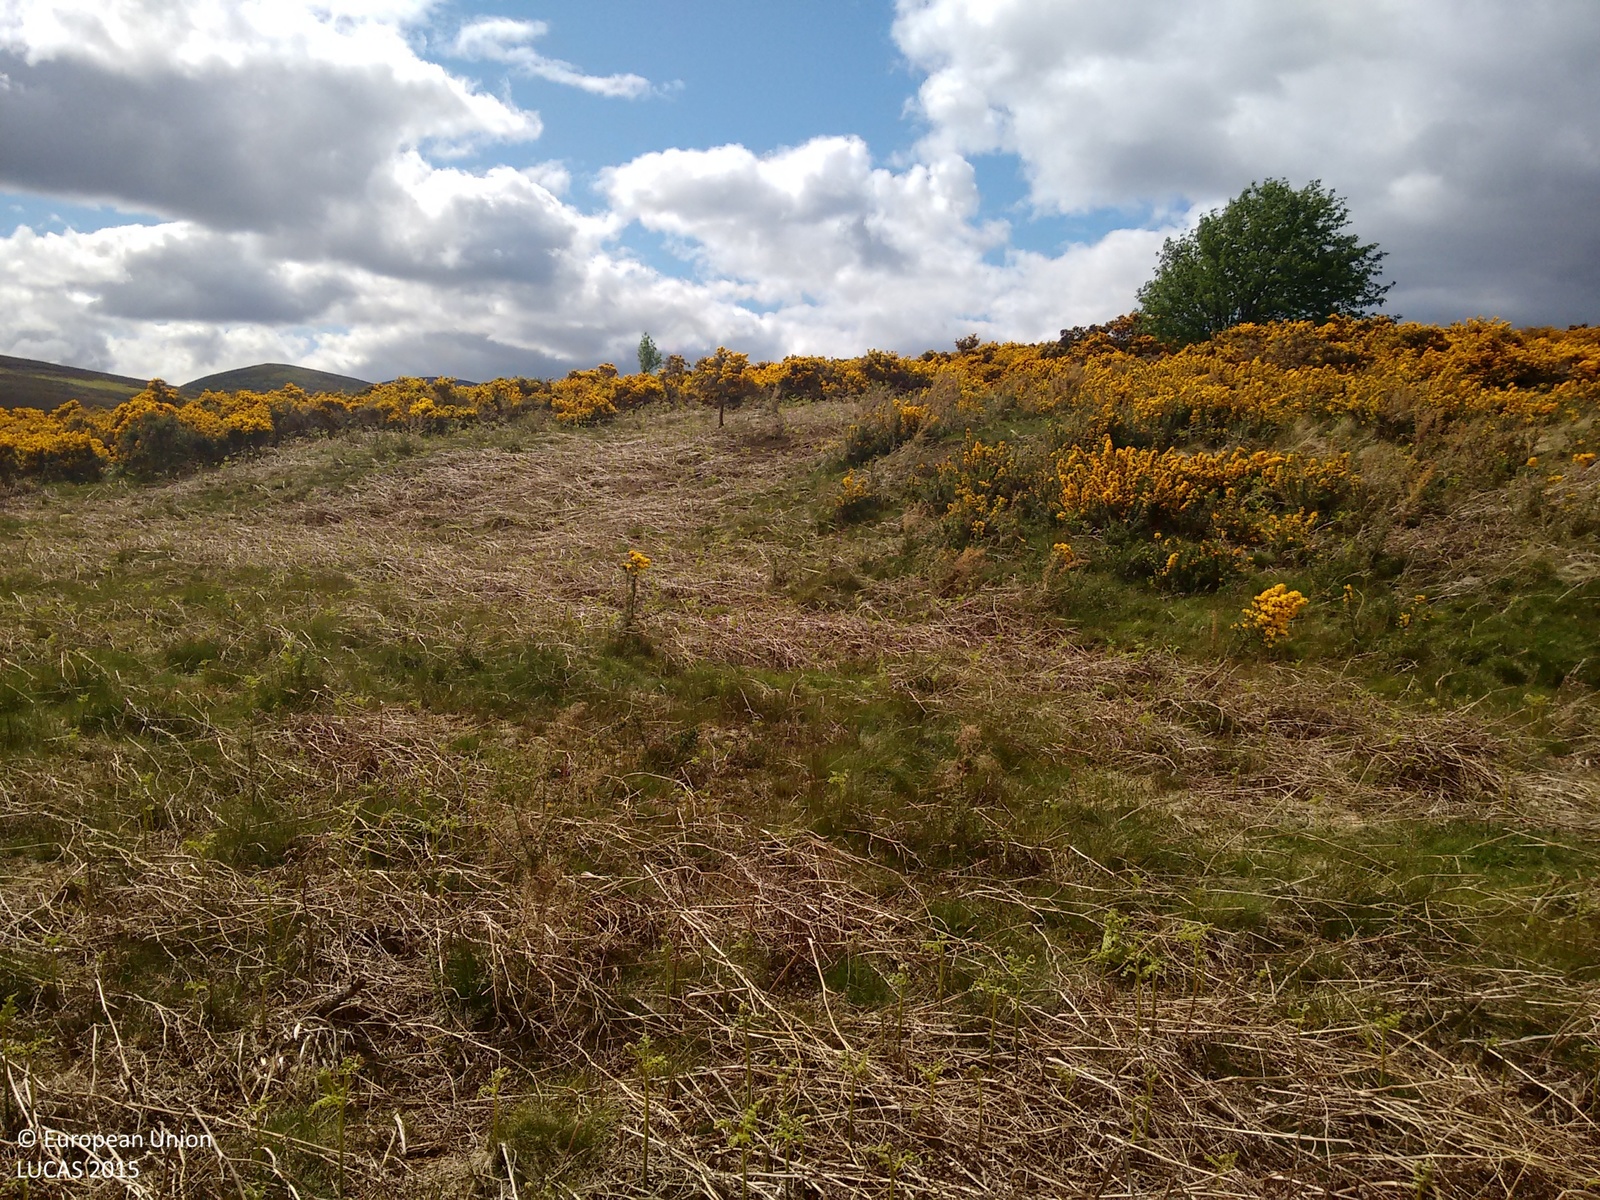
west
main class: Grassland
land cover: Grassland with sparse tree/shrub cover
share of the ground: > 75 %
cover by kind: herbaceous plants 90 %, broadleaved forest trees 5 %, shrubs 5 %
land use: Agriculture (excluding fallow land and kitchen gardens)
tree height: < 5 m
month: June
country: GB
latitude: 57.0017
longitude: -2.6186
